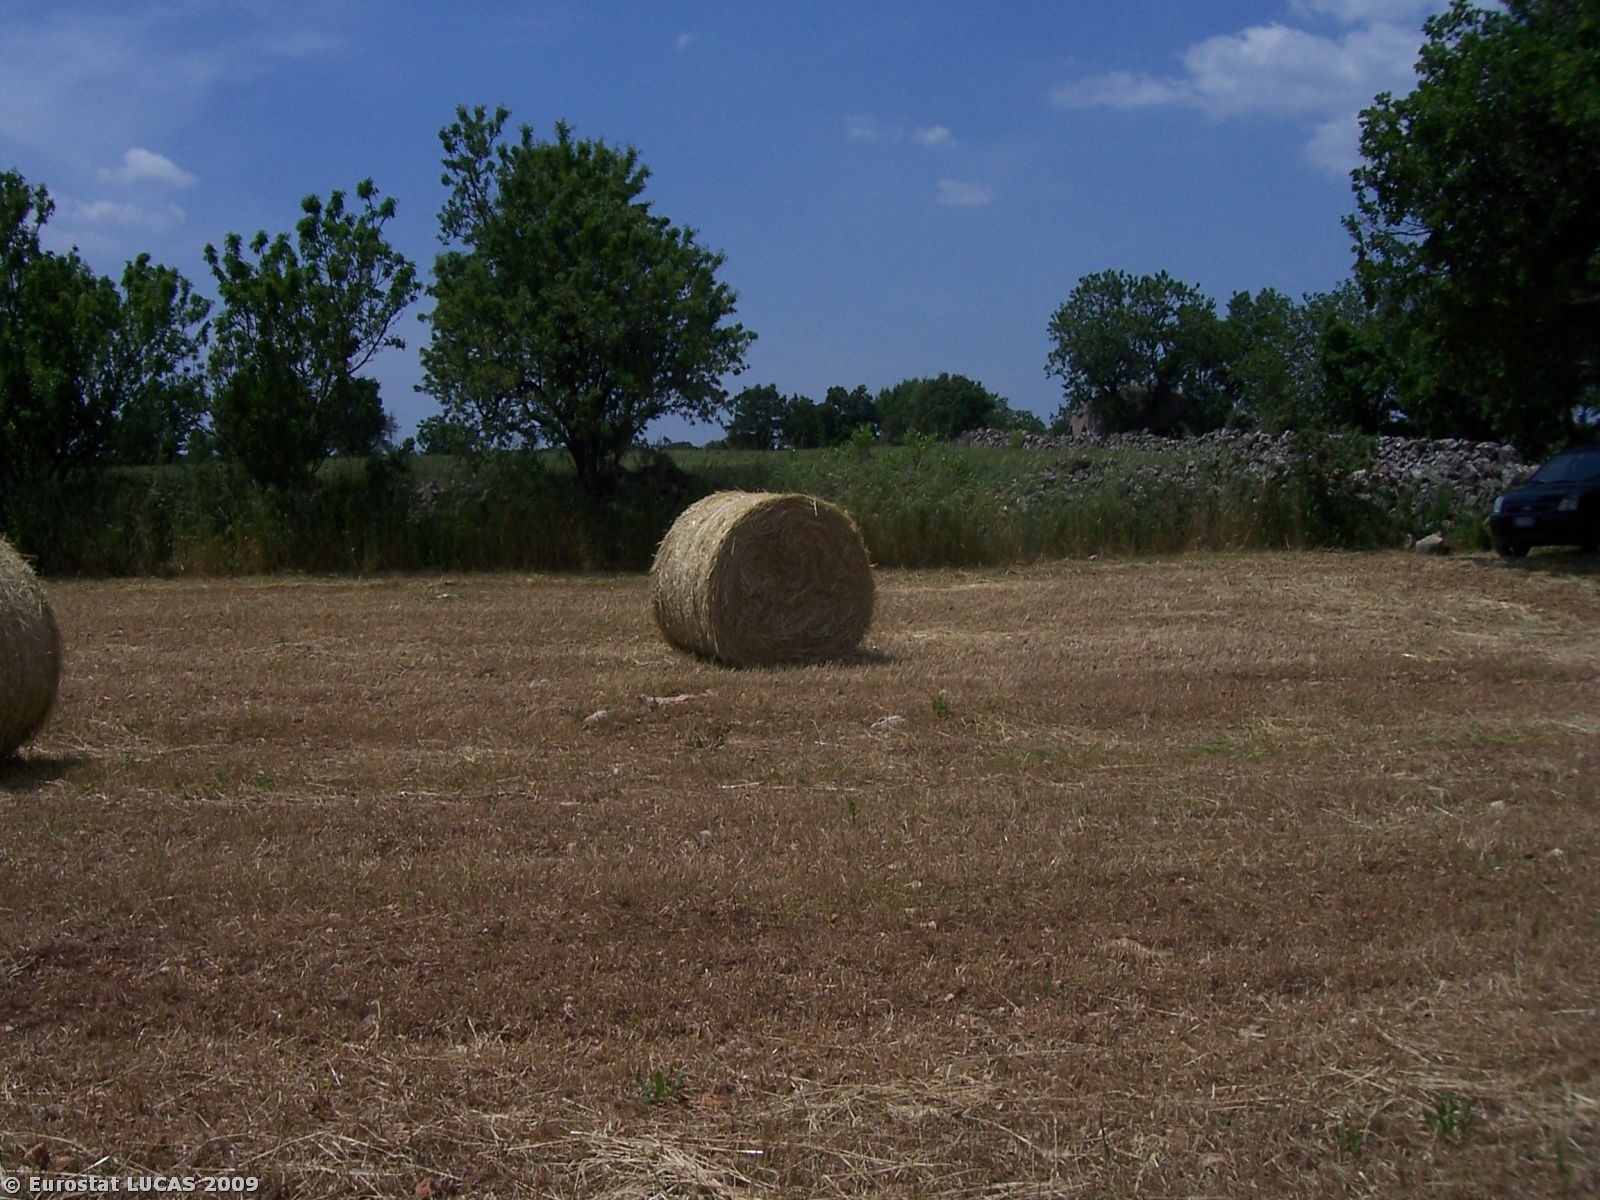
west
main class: Cropland
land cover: Mixed cereals for fodder
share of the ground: < 10 %
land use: Agriculture (excluding fallow land and kitchen gardens)
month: May
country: IT
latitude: 40.7073
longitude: 16.9959
